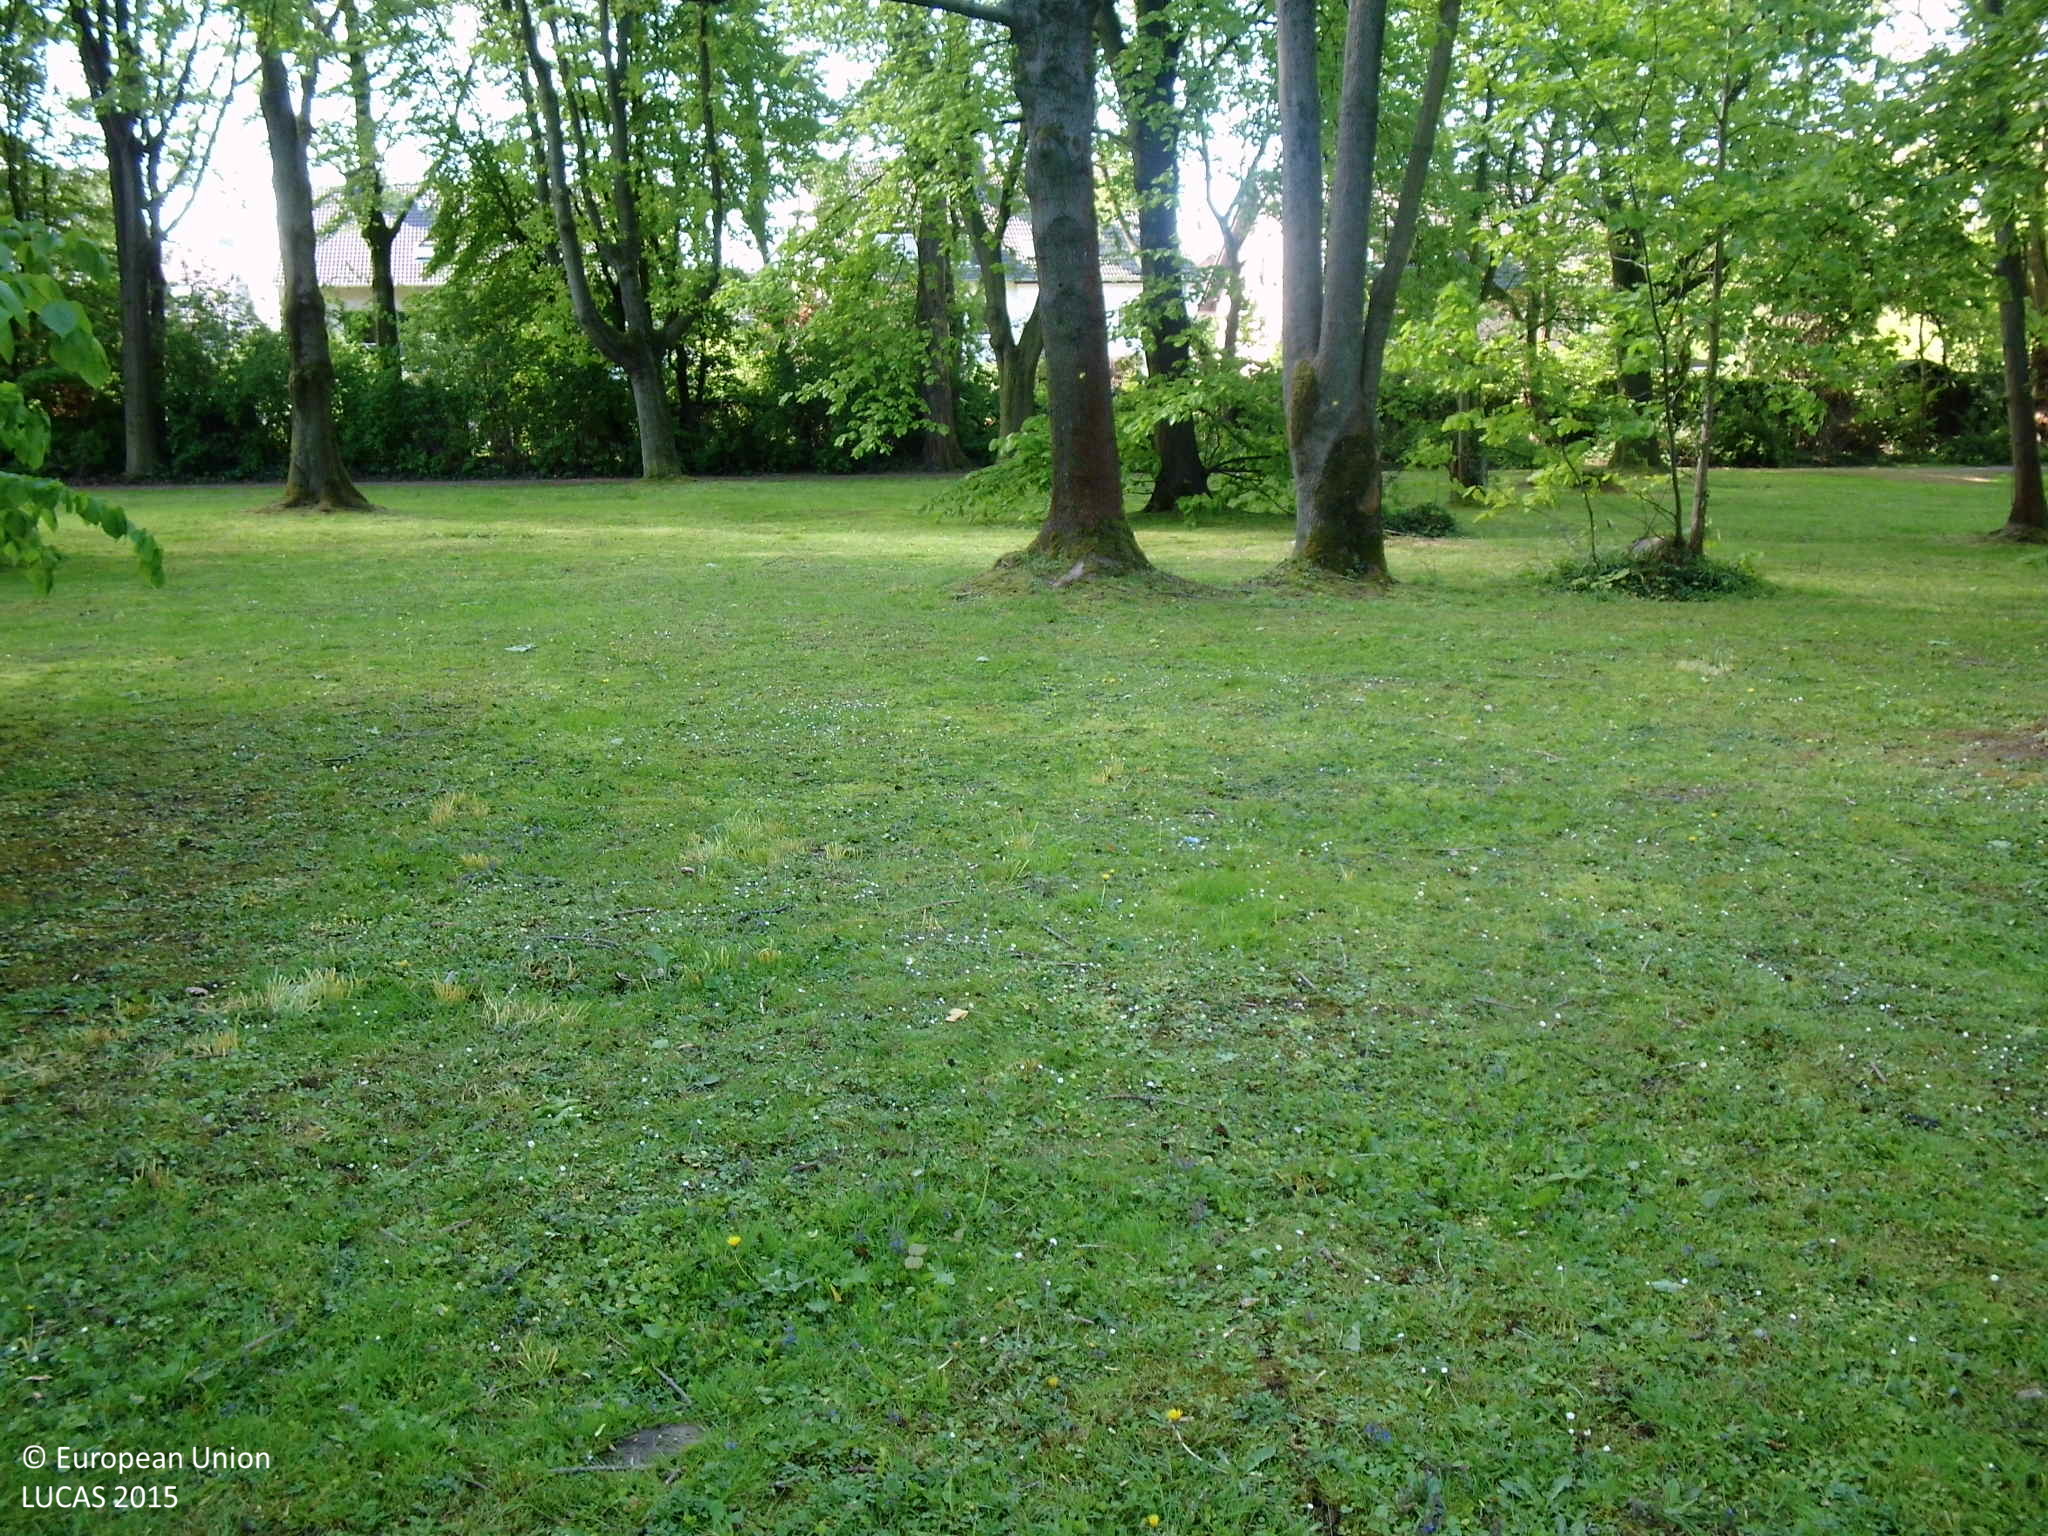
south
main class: Woodland
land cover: Broadleaved woodland
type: mesophytic deciduous forest
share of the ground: > 75 %
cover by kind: broadleaved forest trees 80 %, herbaceous plants 10 %, shrubs 5 %, unconsolidated bare surface 5 %
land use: Community services
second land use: Amenities, museums, leisure
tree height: > 5 m
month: May
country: DE
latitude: 51.5042
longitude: 7.4214
